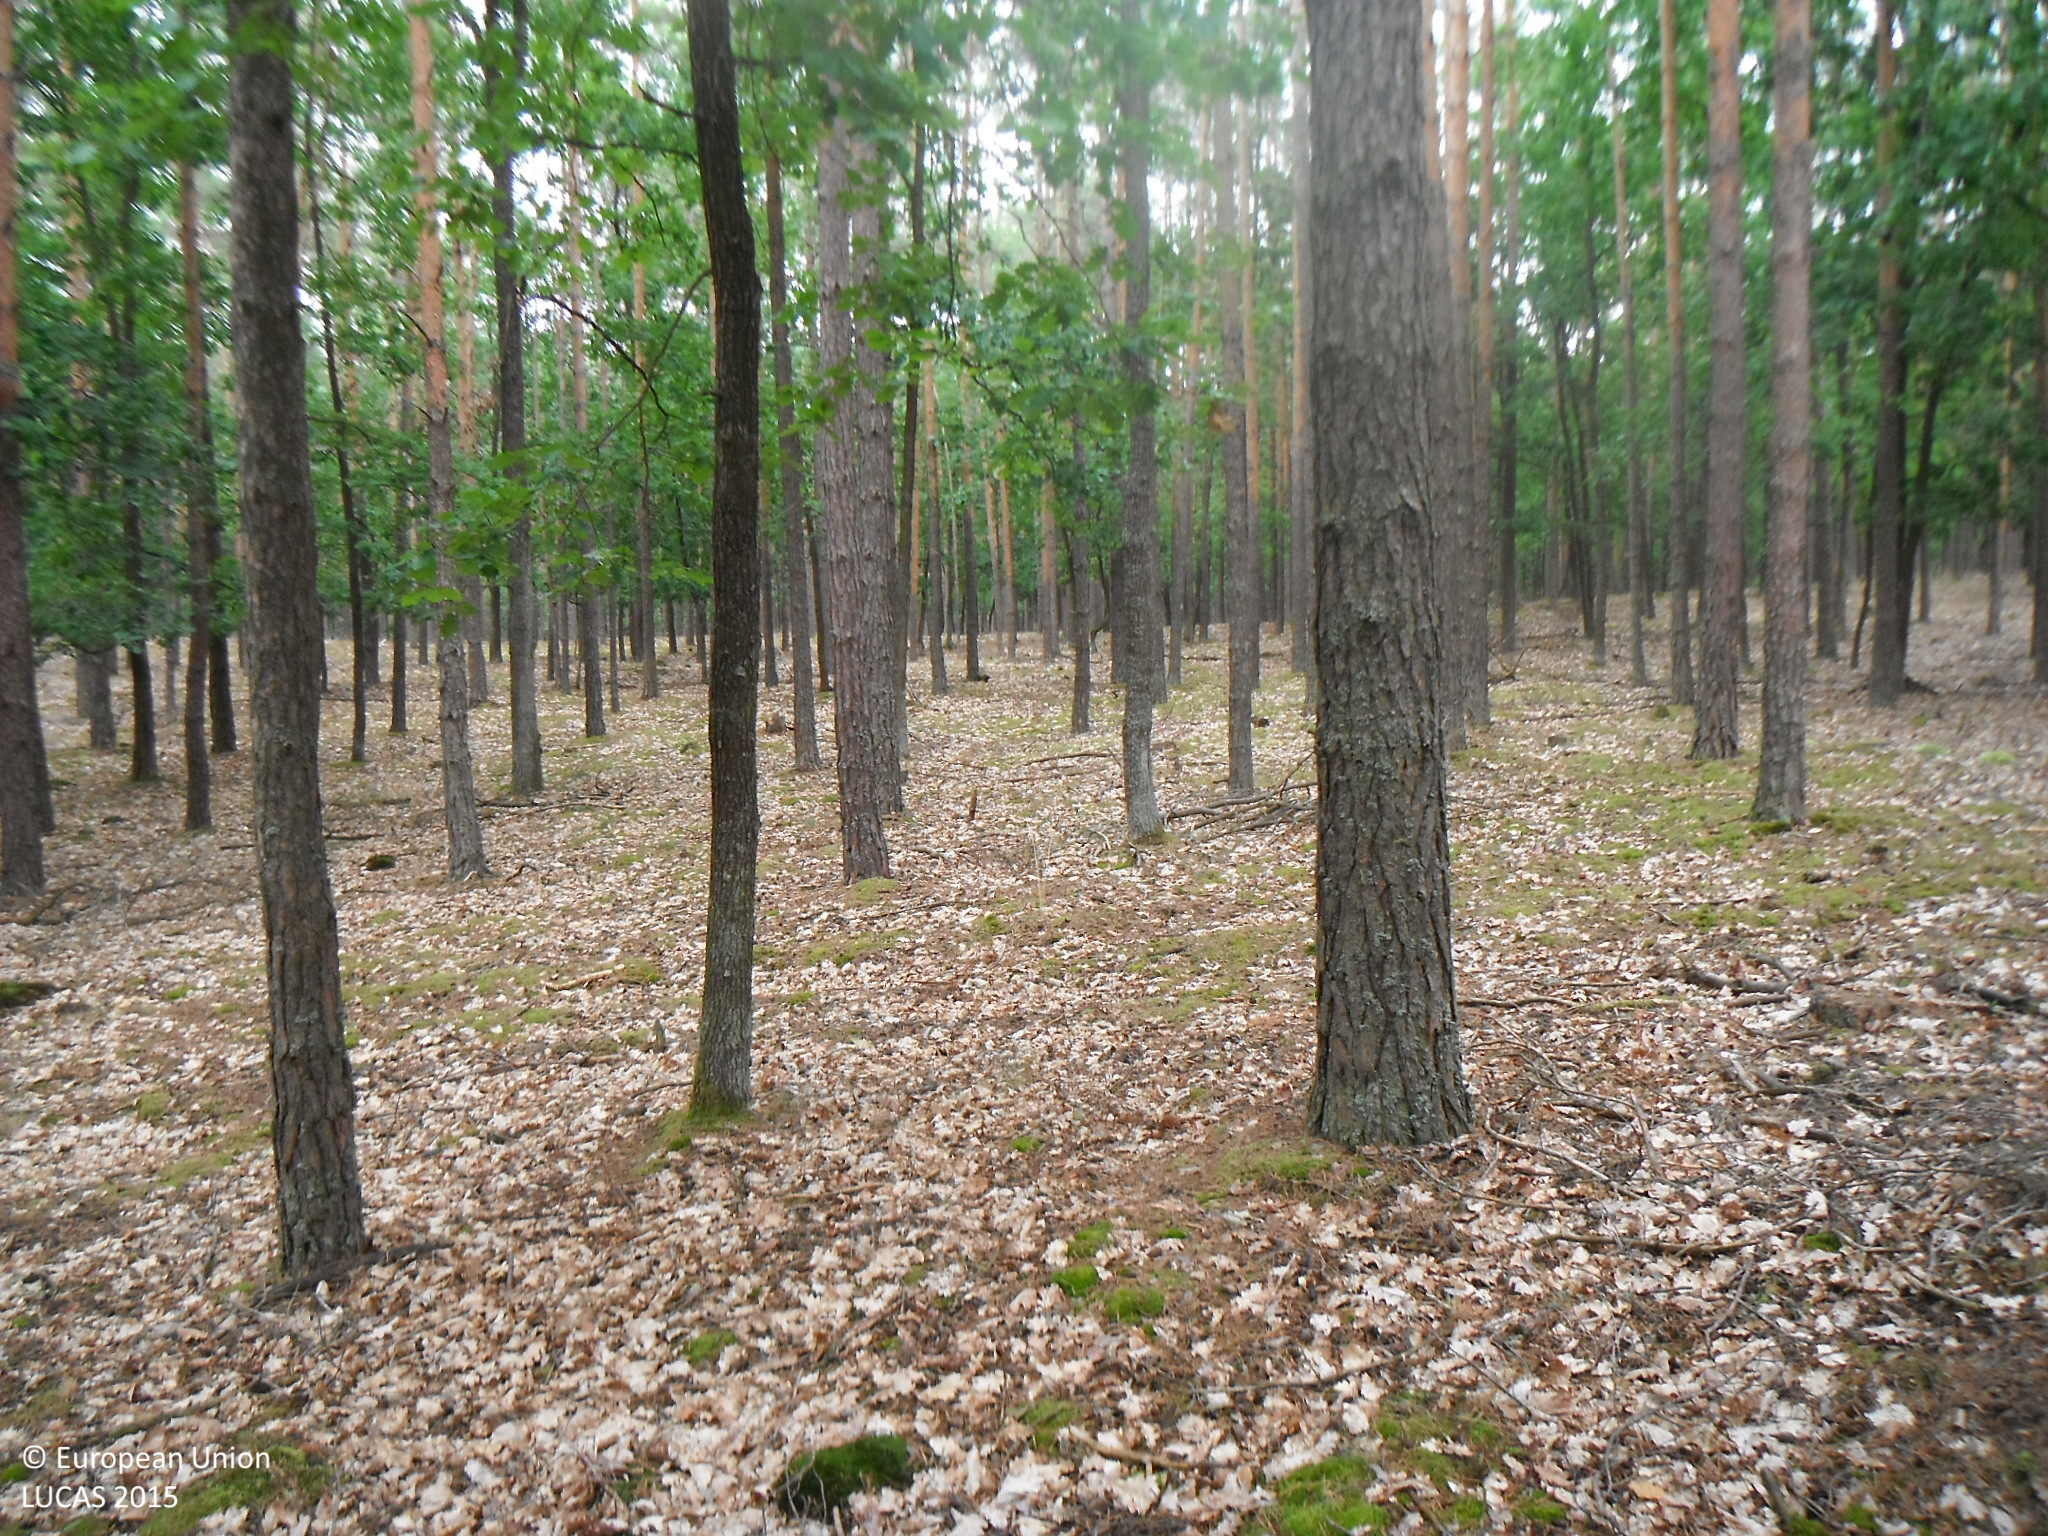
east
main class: Woodland
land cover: Pine dominated mixed woodland
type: hemiboreal forest and nemoral coniferous forest and mixed broadleaved-coniferous forest
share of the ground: > 75 %
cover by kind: coniferous forest trees 45 %, broadleaved forest trees 45 %, lichens and mosses 10 %
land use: Forestry
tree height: > 5 m
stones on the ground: < 10 %
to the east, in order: Pine dominated mixed woodland; Tracks; Pine dominated mixed woodland; Tracks; Pine dominated mixed woodland; Tracks; Pine dominated mixed woodland; Tracks; Pine dominated mixed woodland; Tracks; Pine dominated mixed woodland
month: June
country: SK
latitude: 48.6159
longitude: 17.2667
